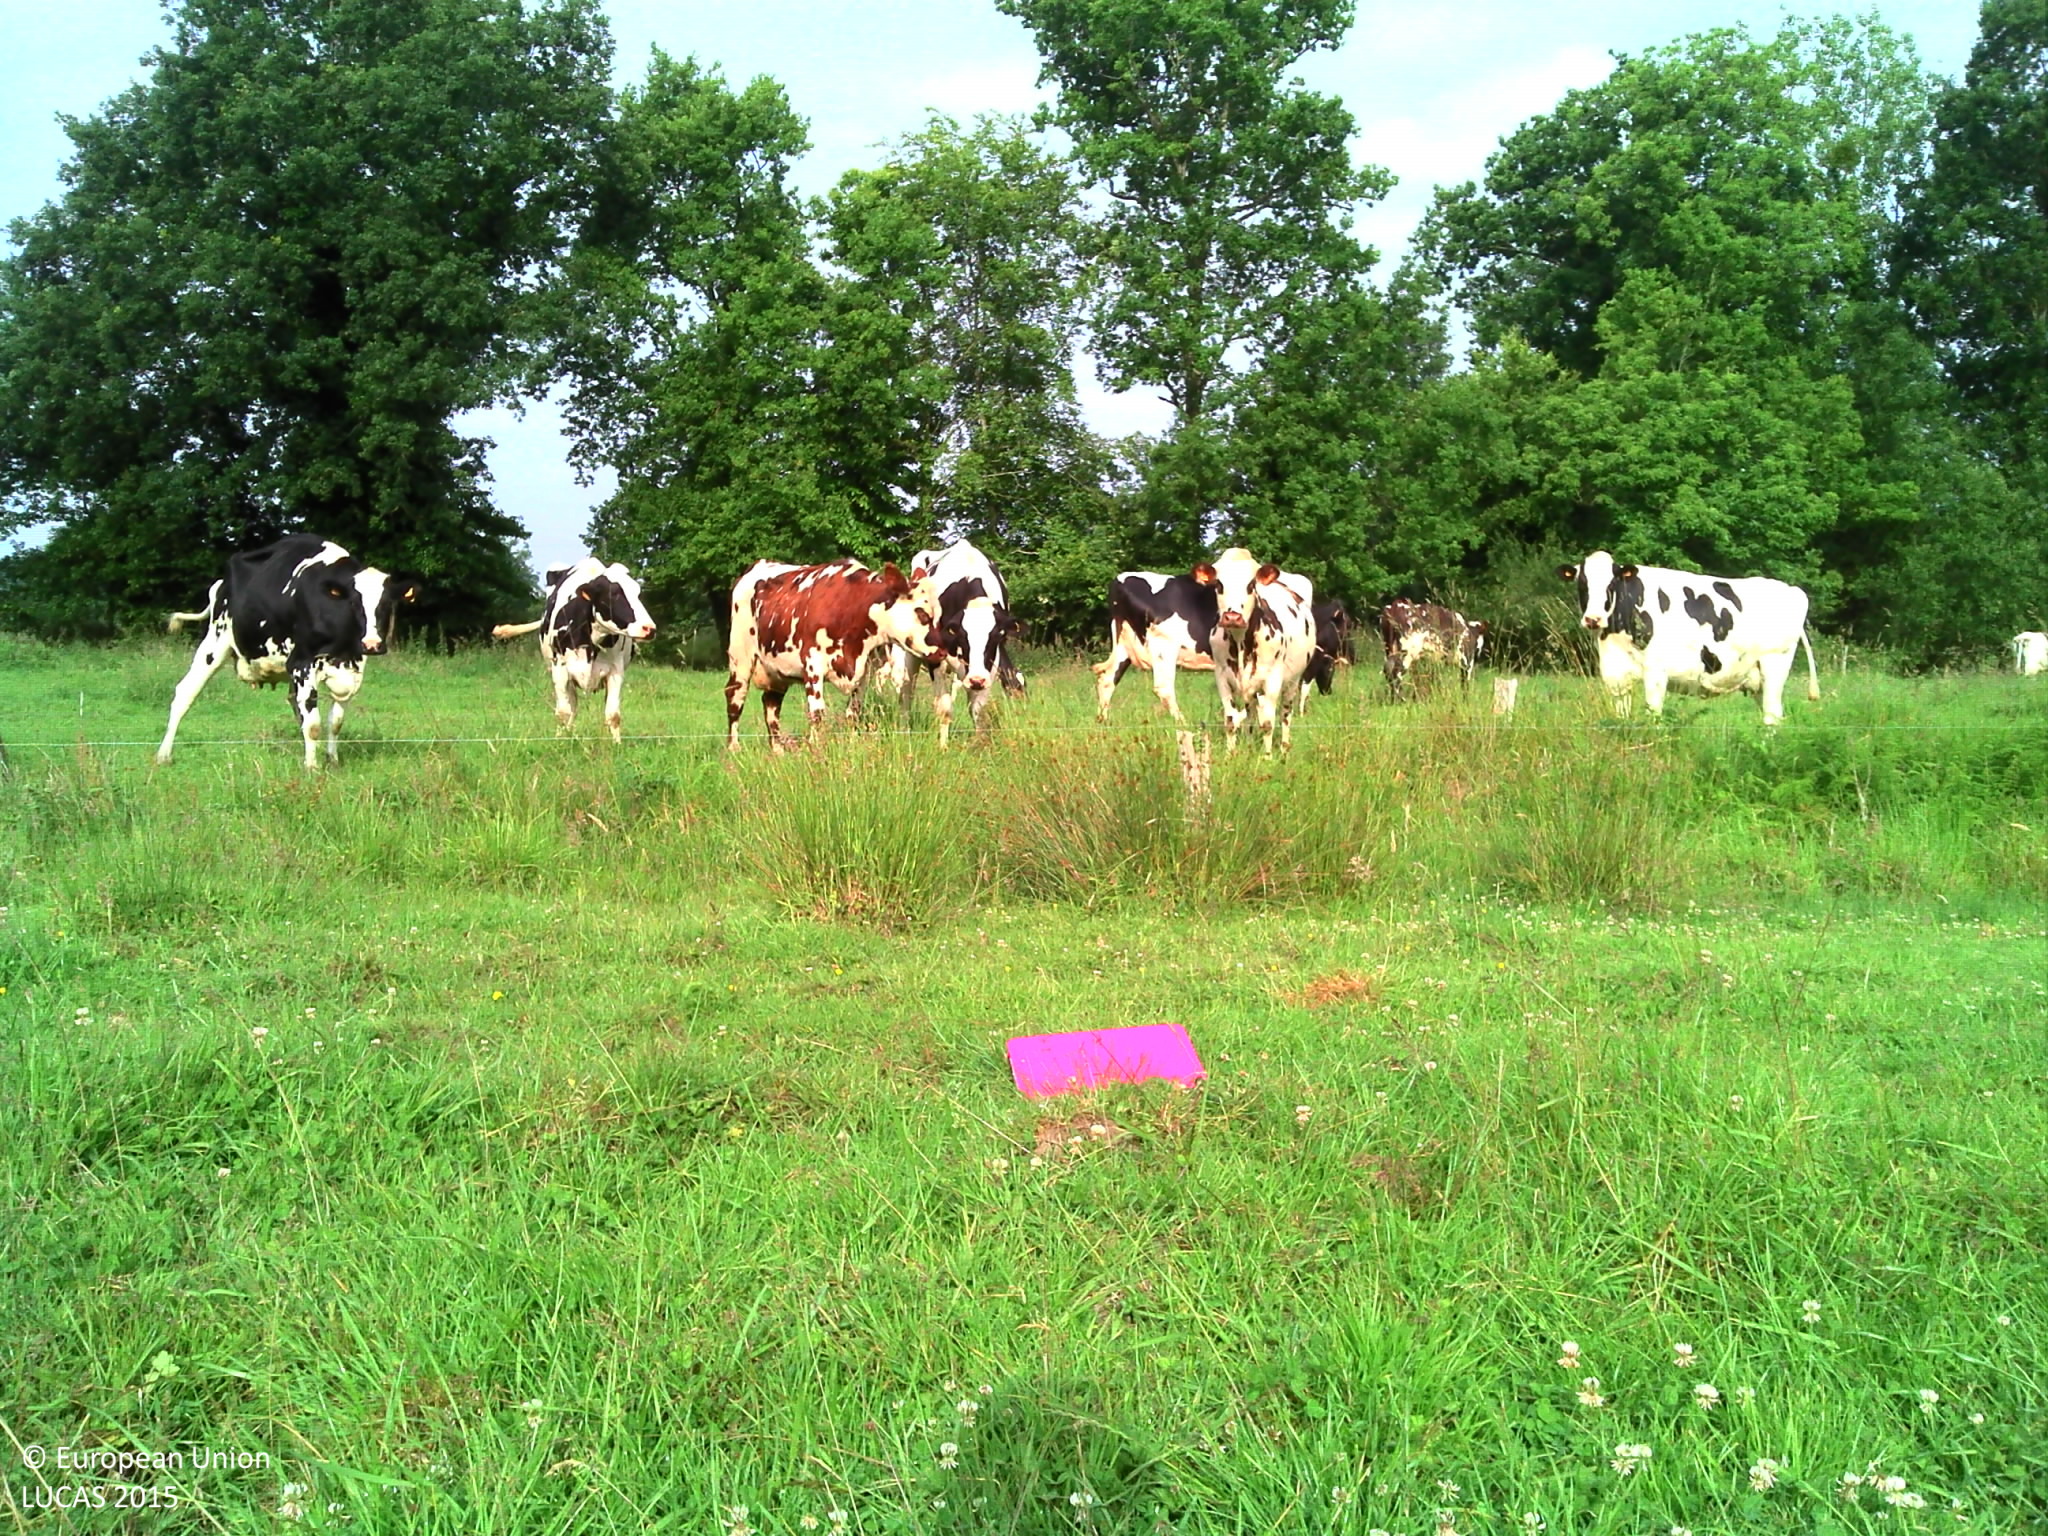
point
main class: Grassland
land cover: Grassland without tree/shrub cover
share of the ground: > 75 %
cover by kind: herbaceous plants 100 %
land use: Agriculture (excluding fallow land and kitchen gardens)
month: June
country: FR
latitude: 48.4094
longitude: -1.7632
